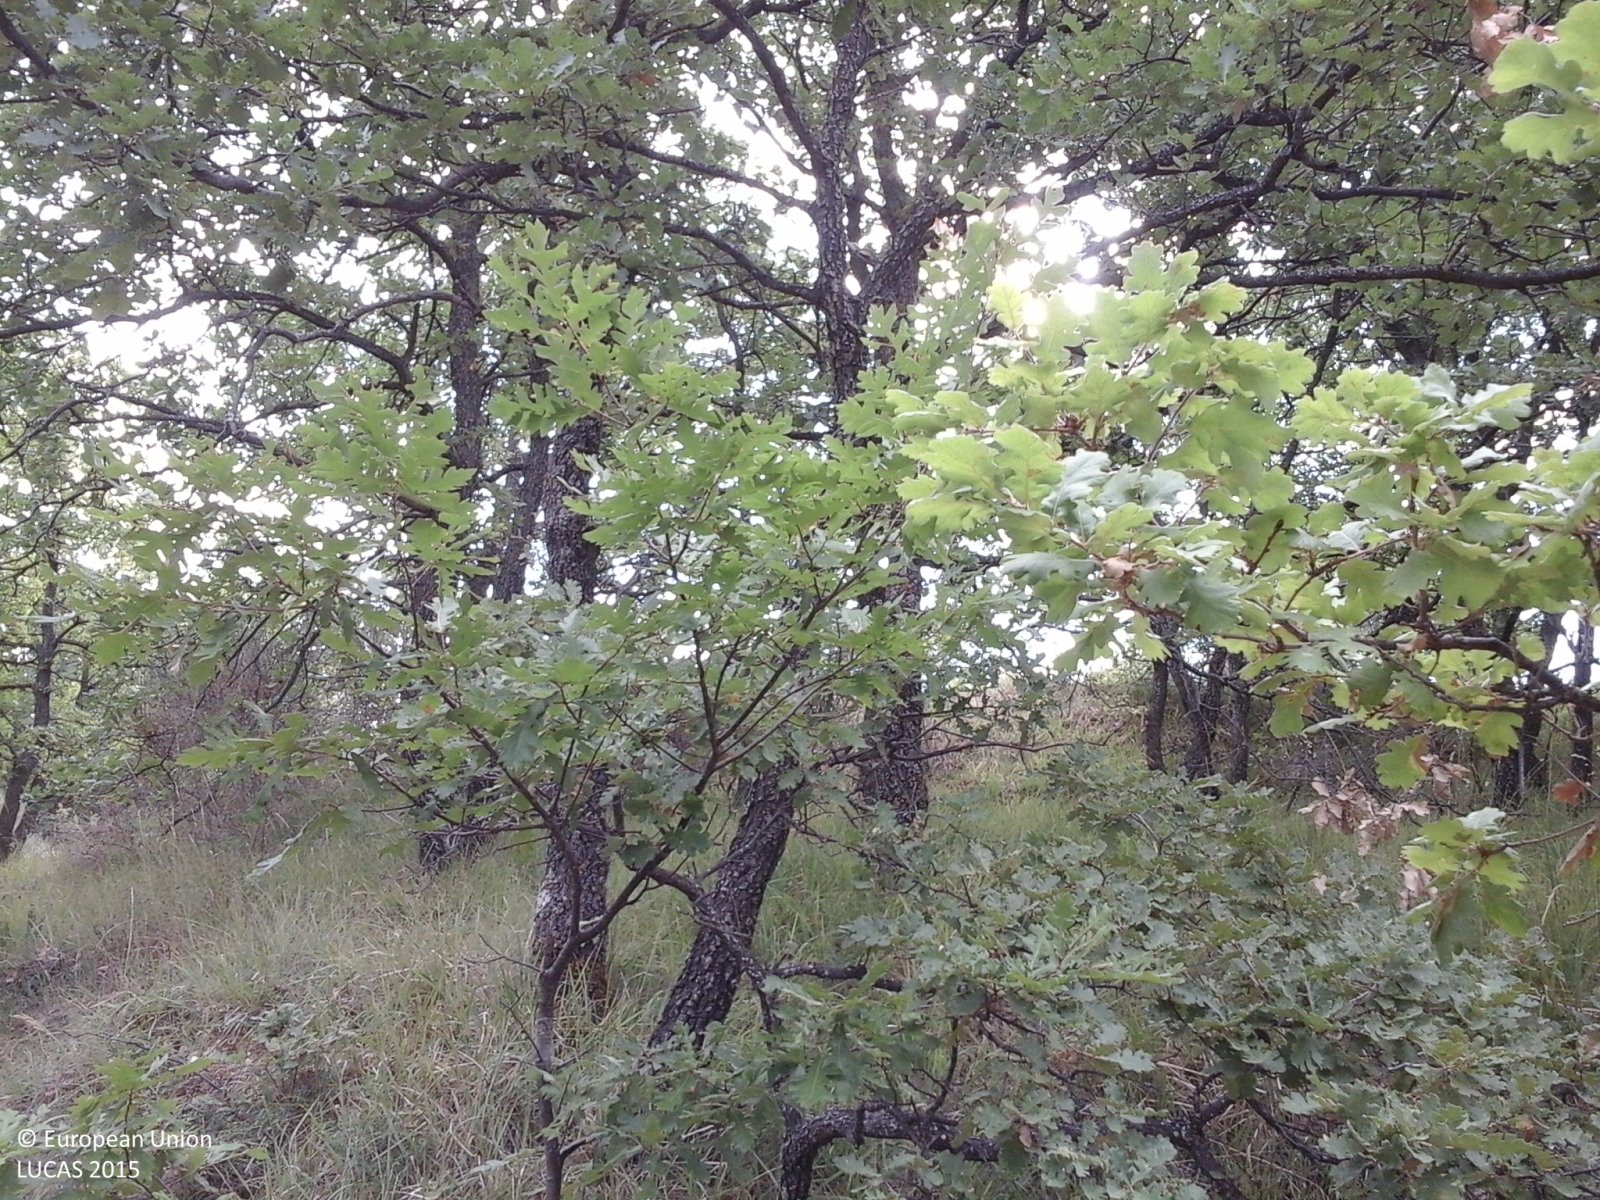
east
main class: Woodland
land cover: Broadleaved woodland
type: thermophilous deciduous forest
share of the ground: > 75 %
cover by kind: broadleaved forest trees 75 %, shrubs 20 %, herbaceous plants 5 %
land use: Semi-natural and natural areas not in use
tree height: > 5 m
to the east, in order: Broadleaved woodland; Shrubland with sparse tree cover; Broadleaved woodland
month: August
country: IT
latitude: 41.7985
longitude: 14.4019
